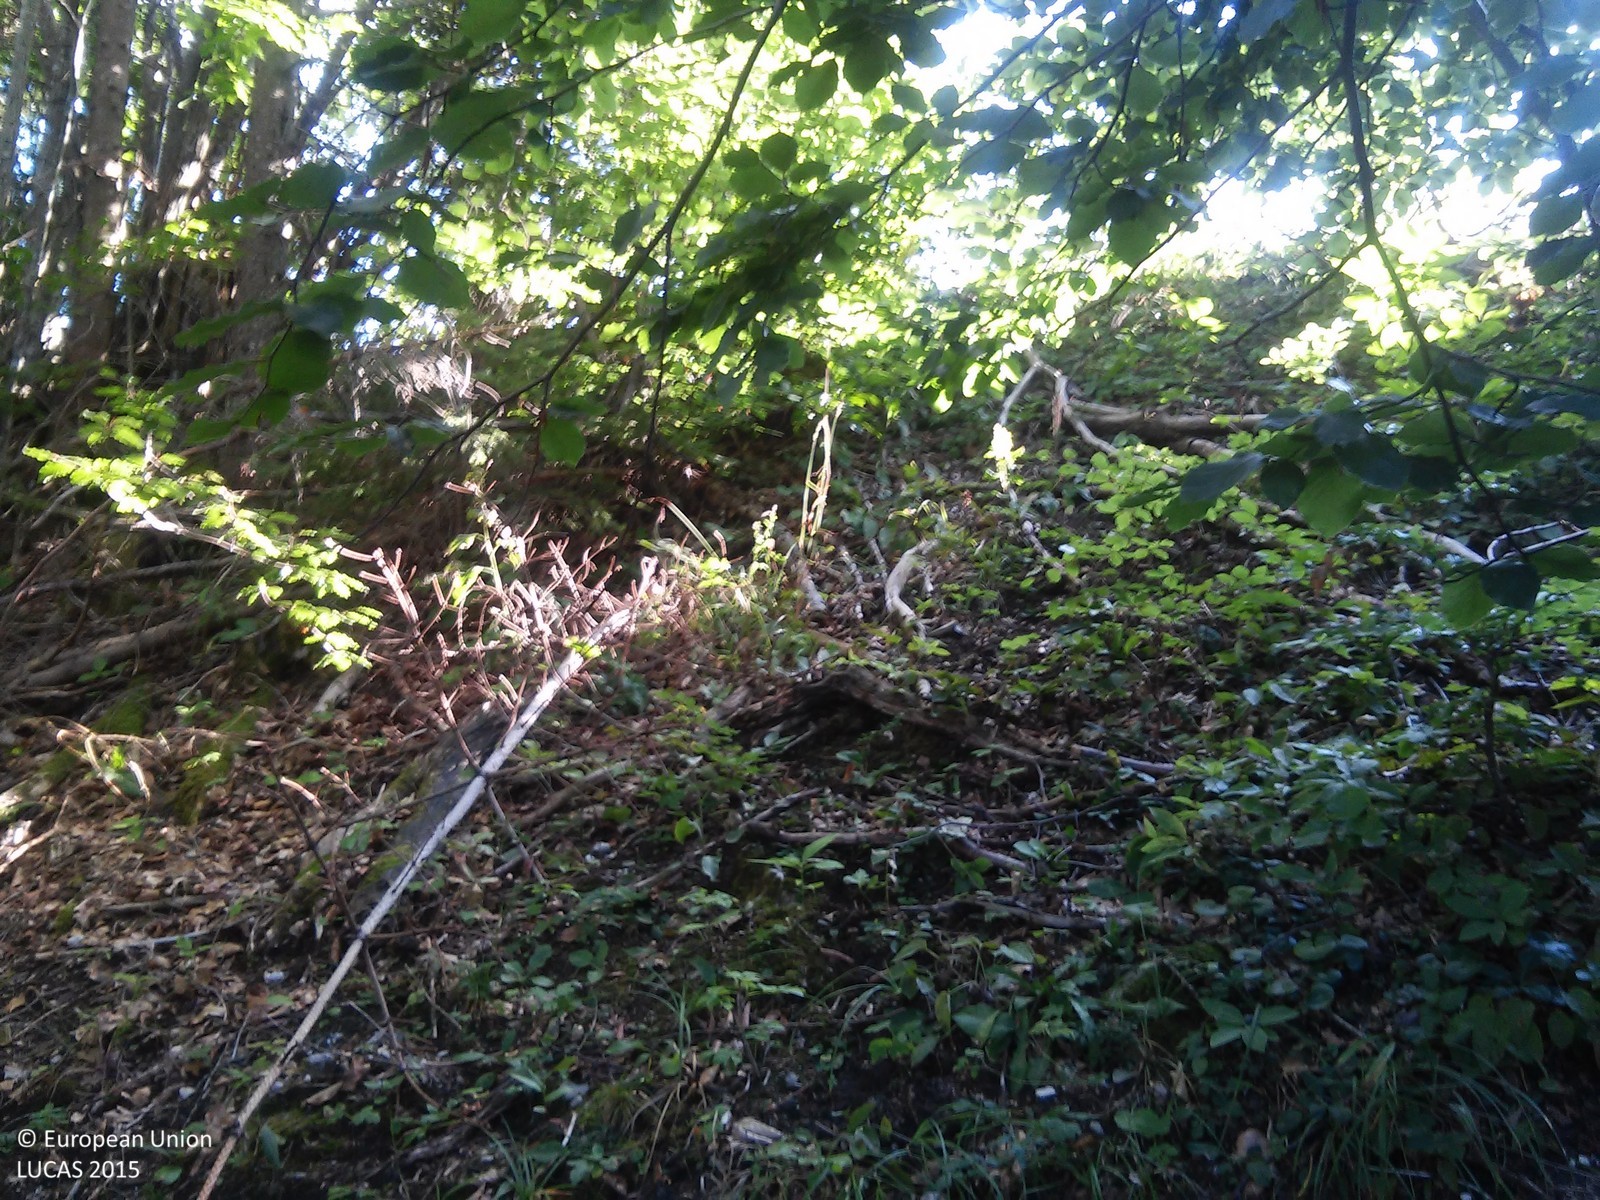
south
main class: Woodland
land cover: Other mixed woodland
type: mountainous beech forest
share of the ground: > 75 %
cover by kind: broadleaved forest trees 75 %, coniferous forest trees 25 %
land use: Forestry
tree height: > 5 m
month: September
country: HR
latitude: 45.6208
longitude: 14.5999
